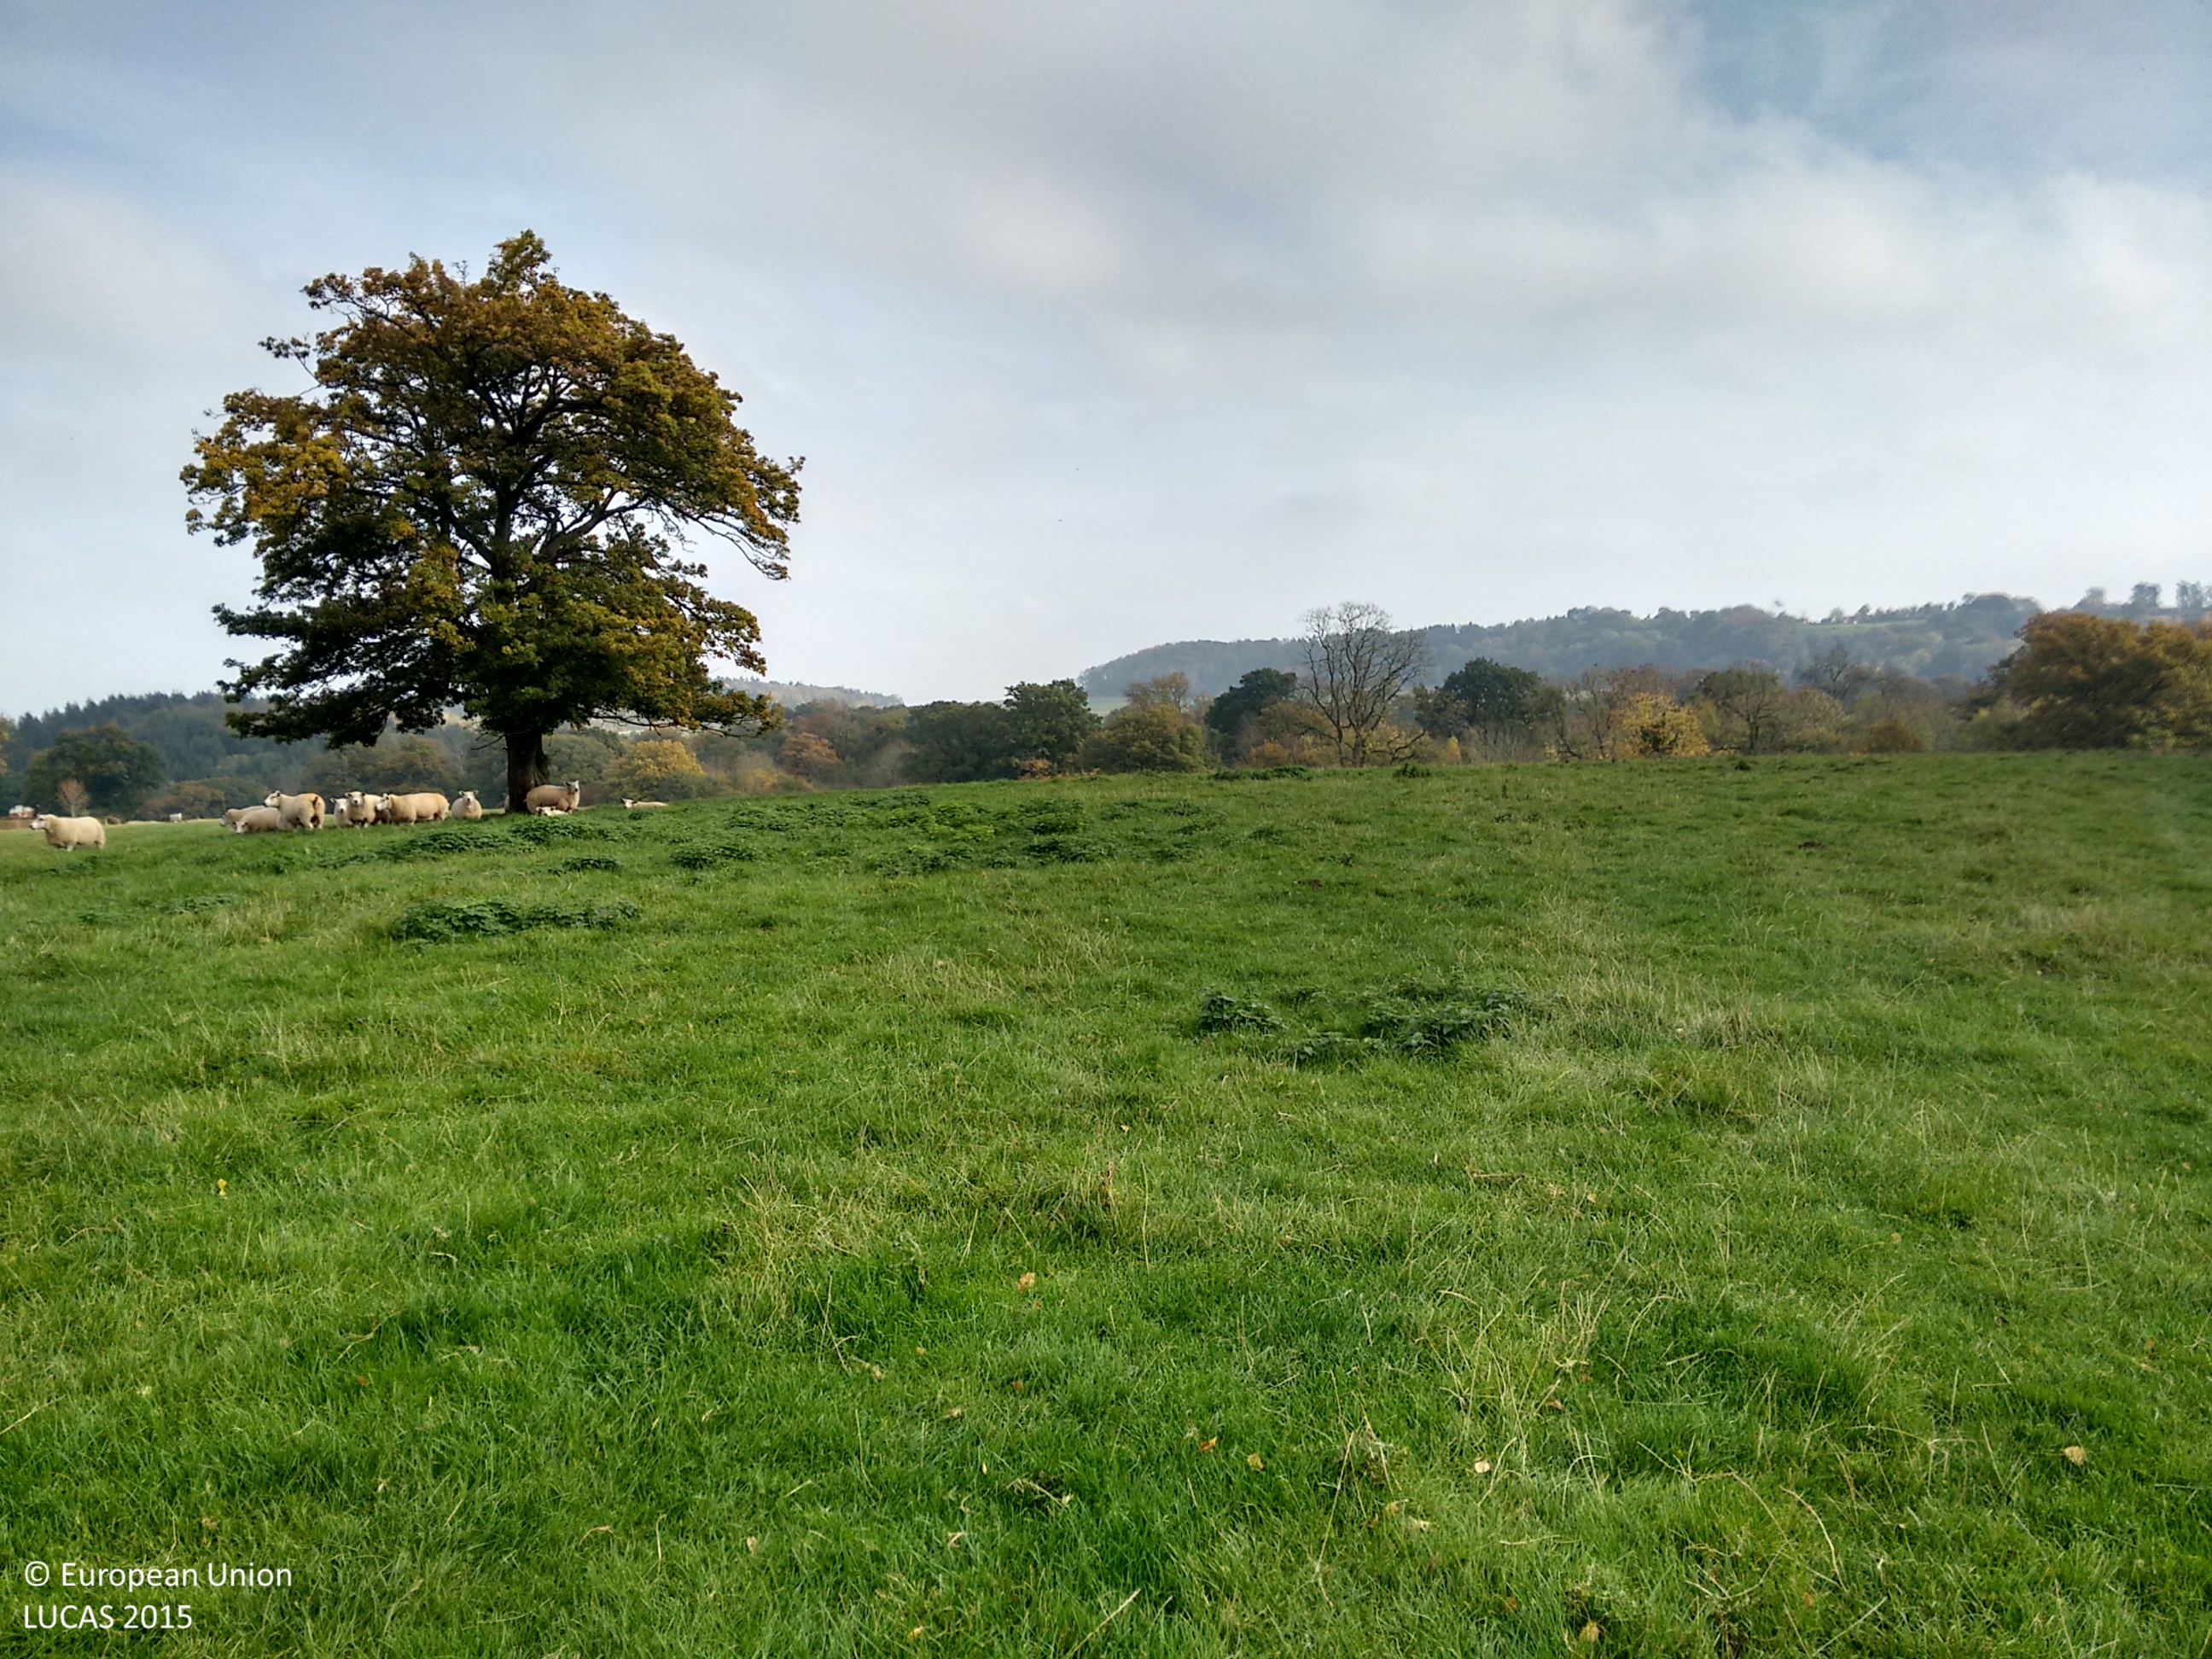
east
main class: Grassland
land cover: Grassland without tree/shrub cover
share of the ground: > 75 %
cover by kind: herbaceous plants 100 %
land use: Agriculture (excluding fallow land and kitchen gardens)
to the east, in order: Grassland without tree/shrub cover; Single bushes/trees; Grassland without tree/shrub cover; Broadleaved woodland; Rivers and streams
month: October
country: GB
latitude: 52.6061
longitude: -2.6648
